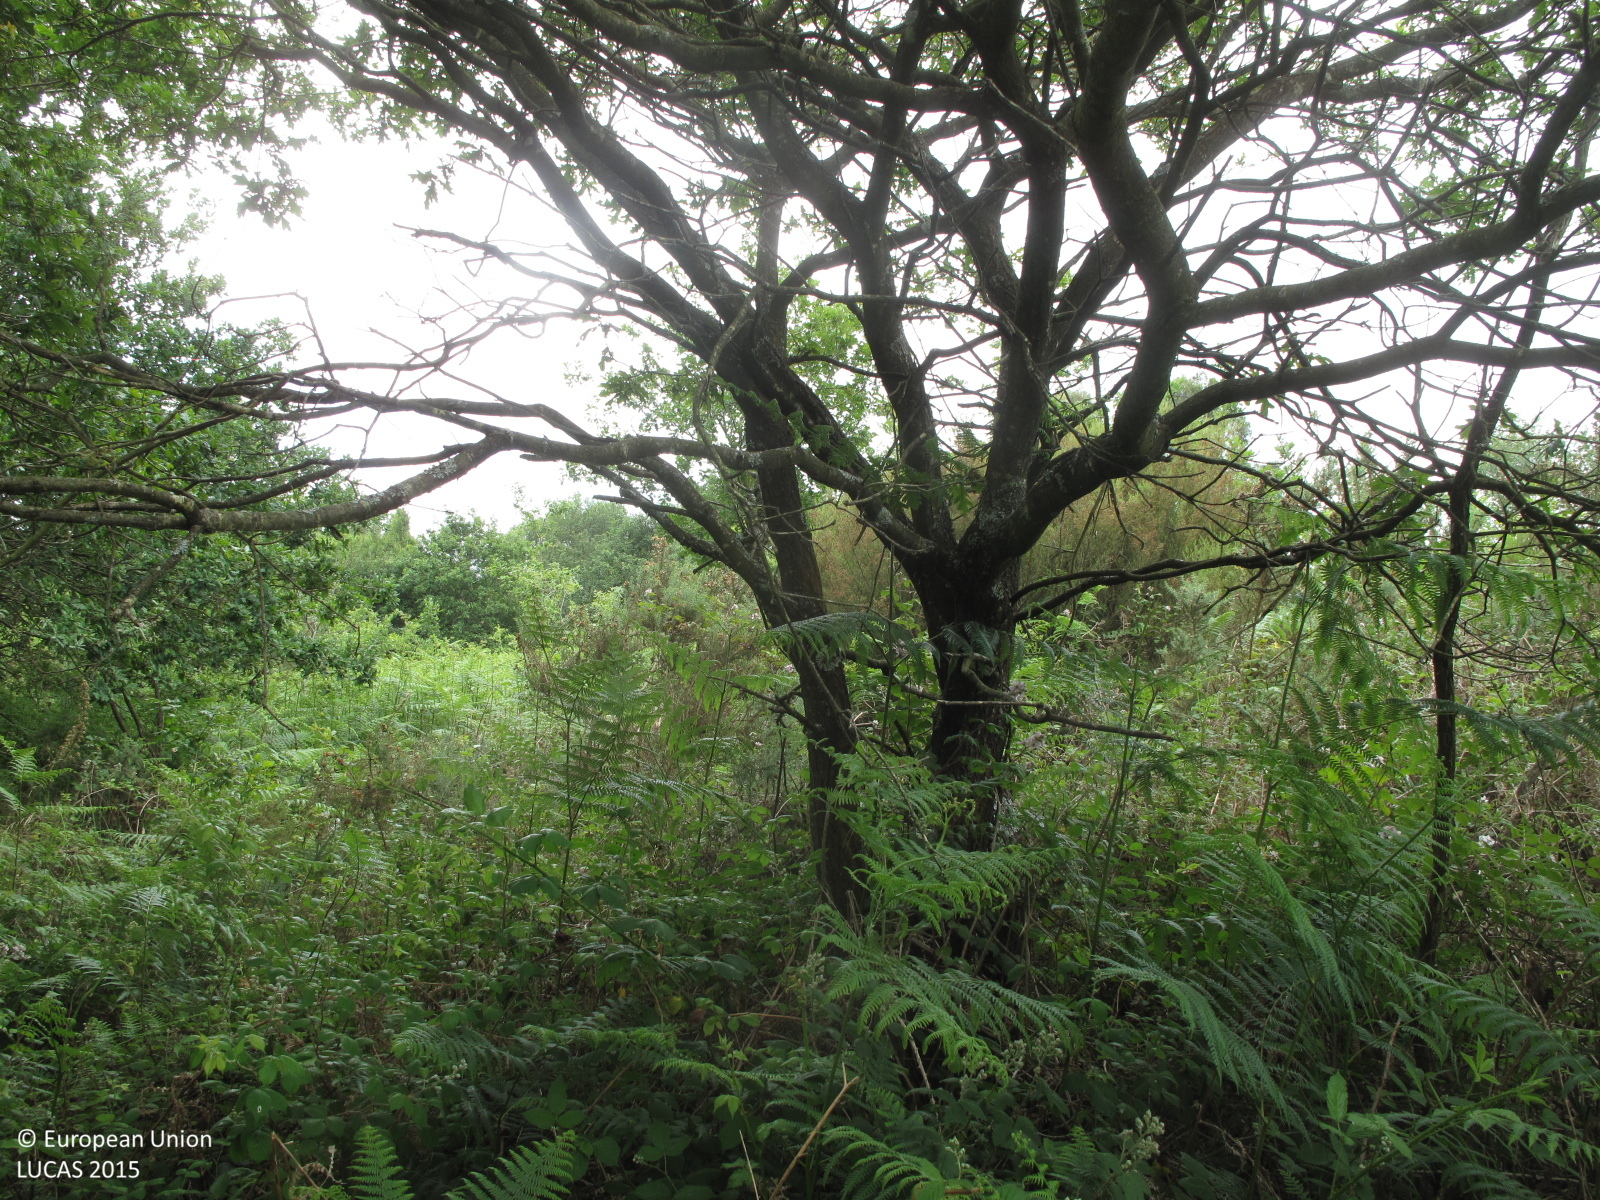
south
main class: Woodland
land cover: Broadleaved woodland
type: acidophilous oak and oak-birch forest
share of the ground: 50 - 75 %
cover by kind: broadleaved forest trees 60 %, shrubs 30 %, herbaceous plants 10 %
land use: Semi-natural and natural areas not in use
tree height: > 5 m
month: June
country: ES
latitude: 43.0943
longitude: -8.4977
